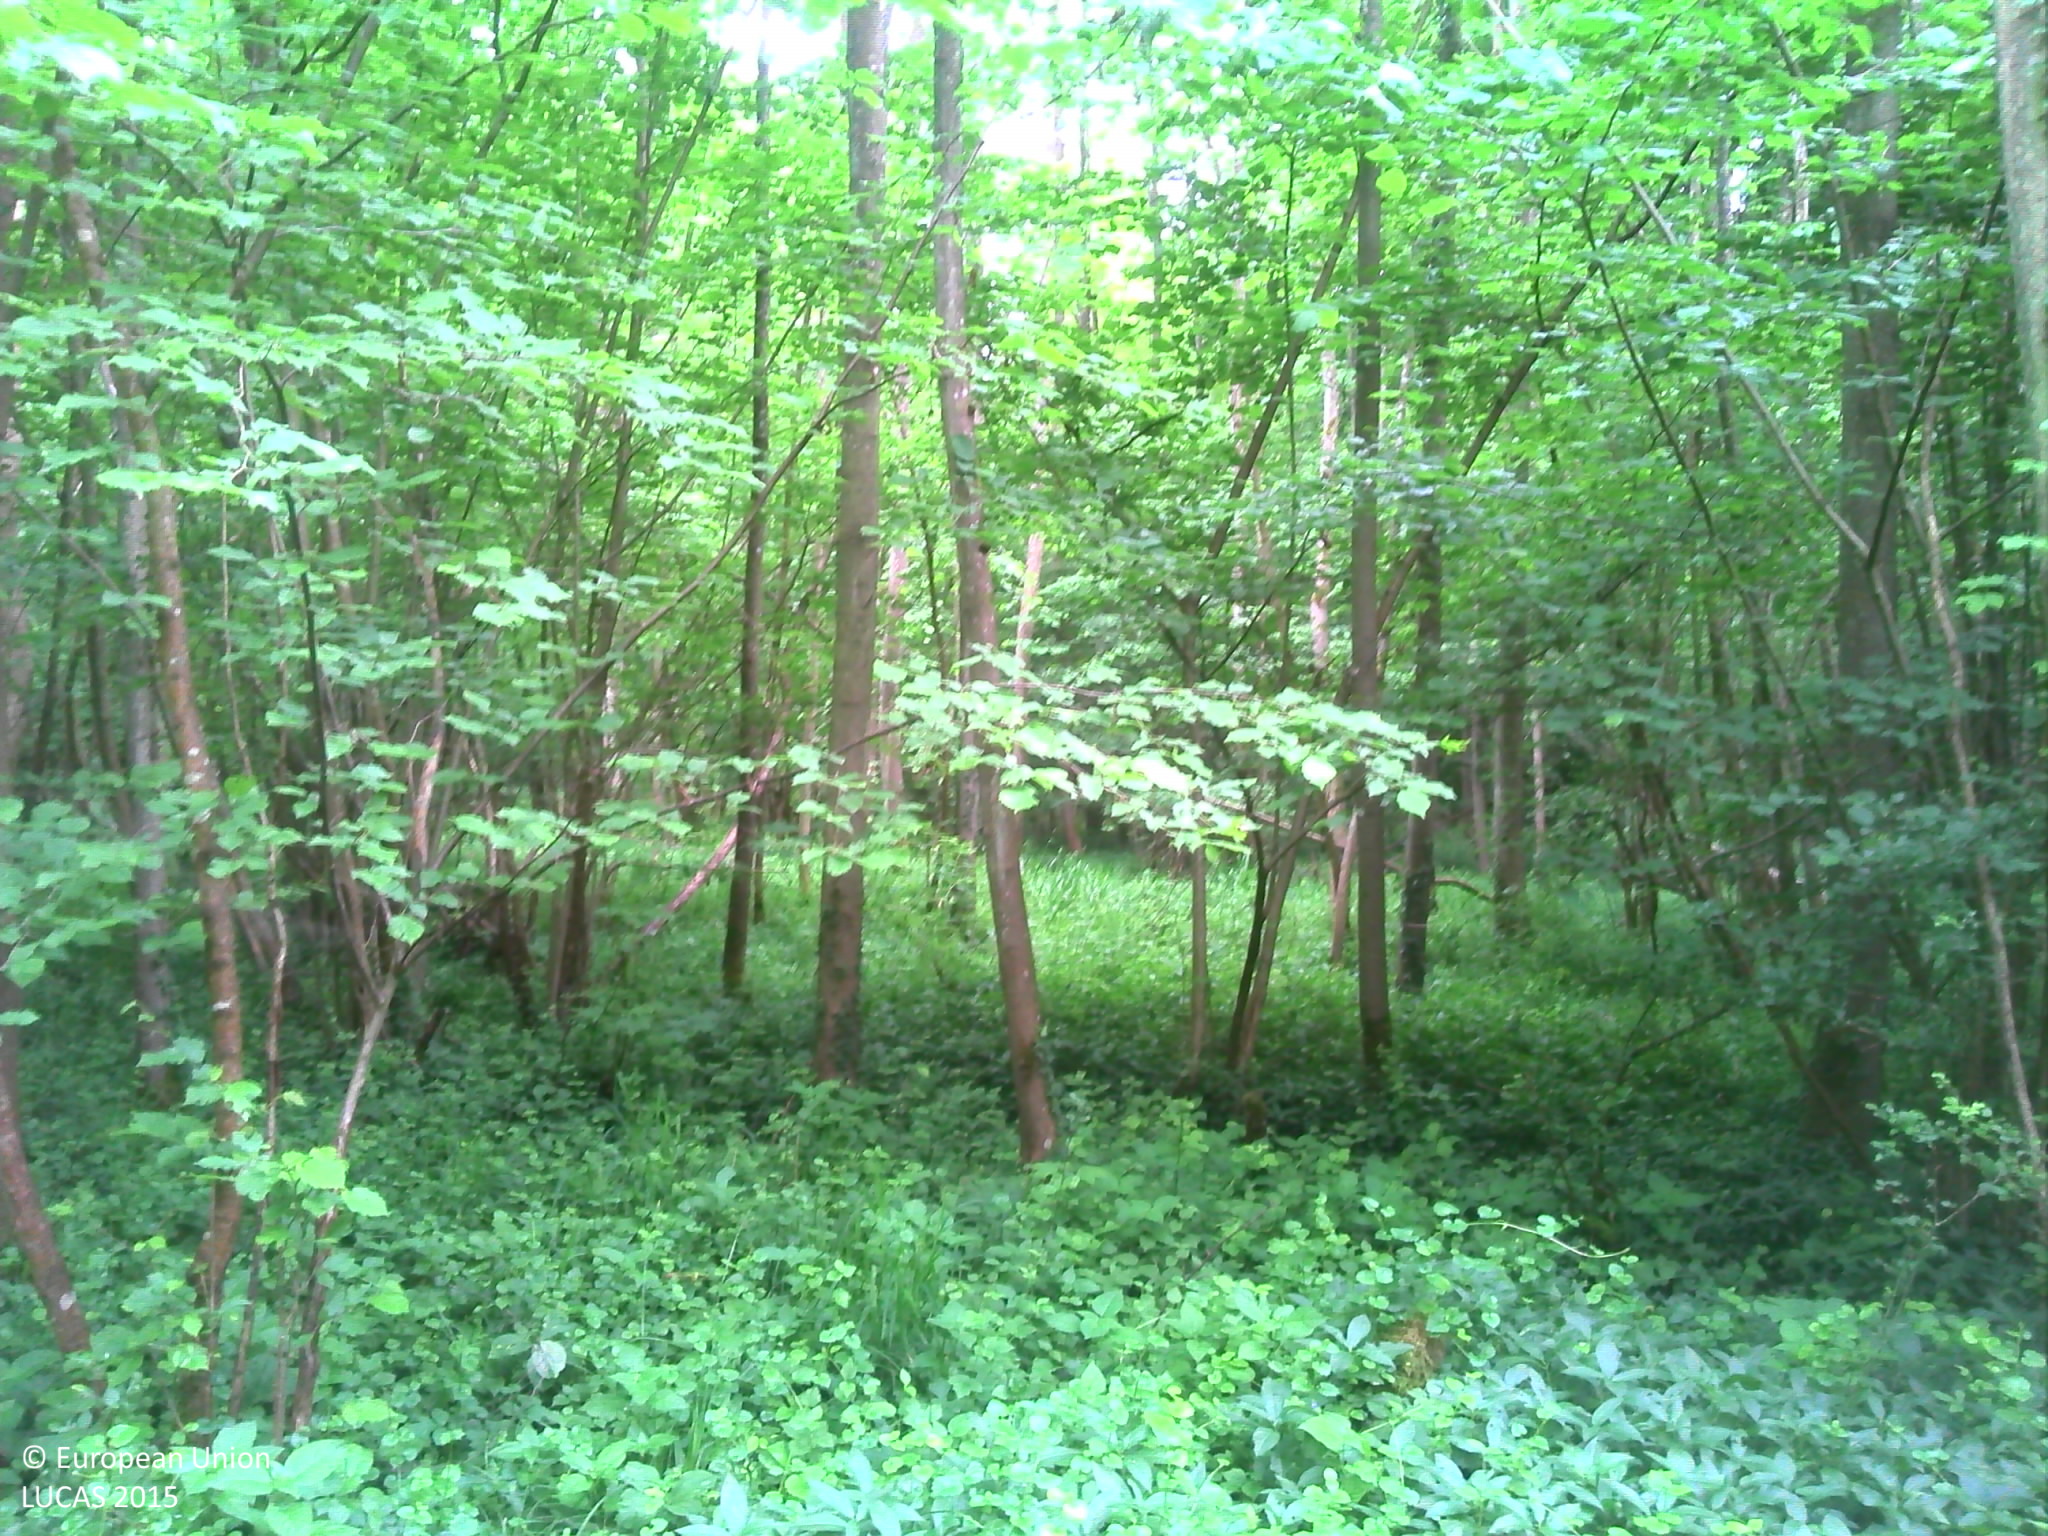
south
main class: Woodland
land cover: Broadleaved woodland
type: mesophytic deciduous forest
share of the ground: > 75 %
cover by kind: broadleaved forest trees 90 %, herbaceous plants 10 %
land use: Forestry
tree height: > 5 m
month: May
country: FR
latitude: 48.3226
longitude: 7.5599
